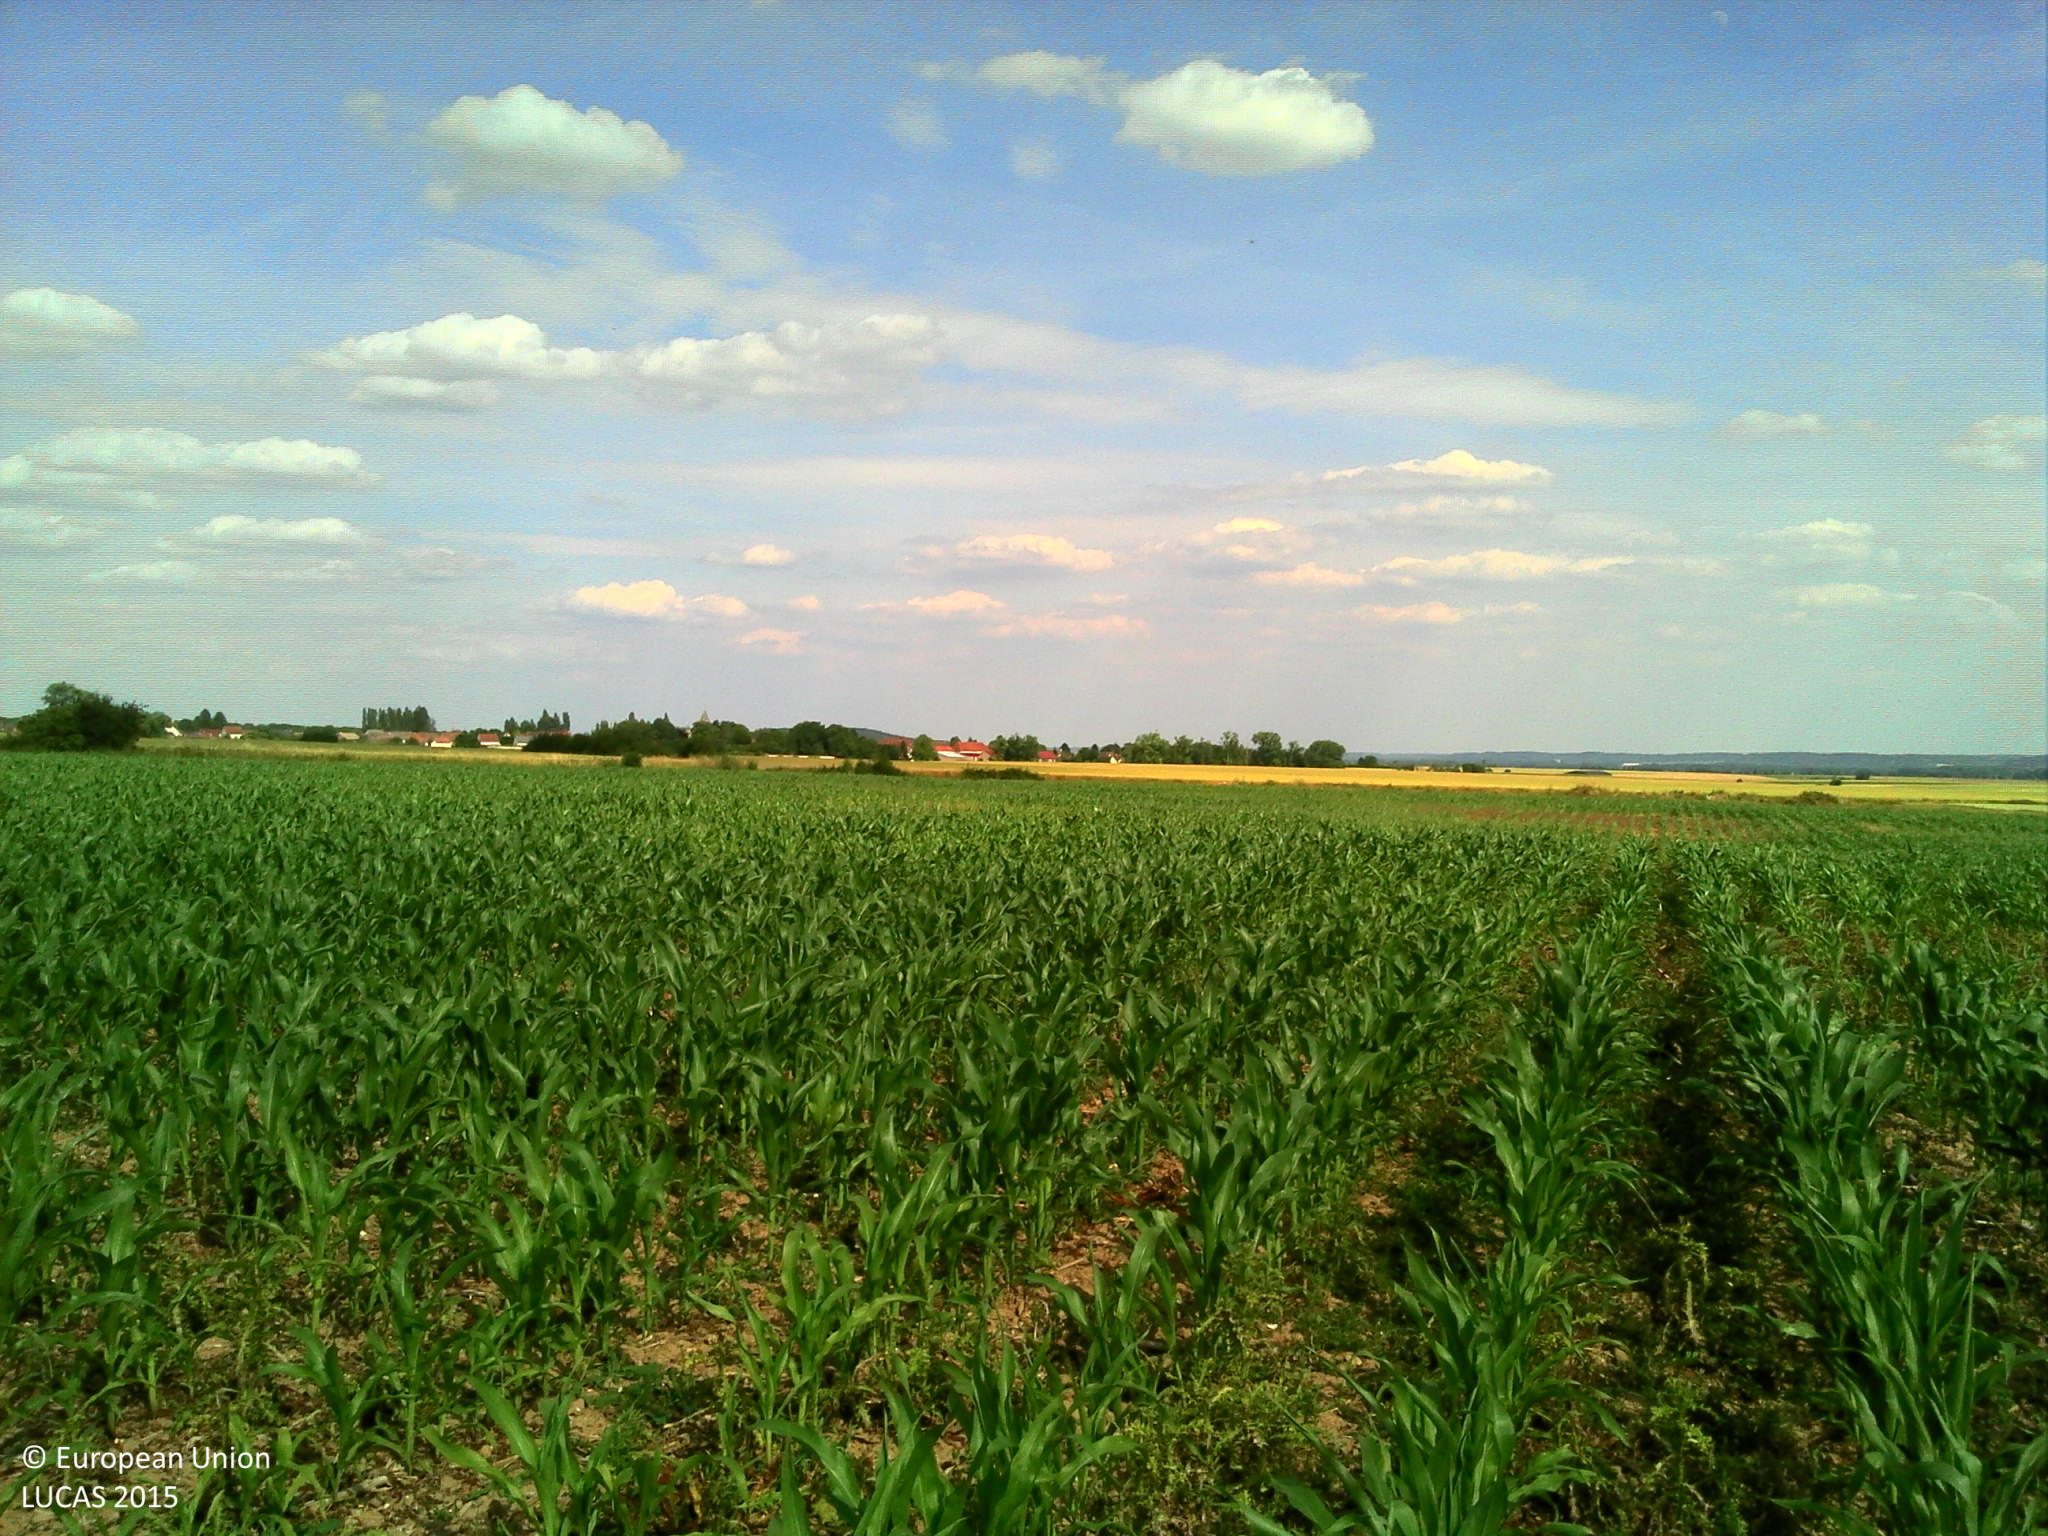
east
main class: Cropland
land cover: Maize
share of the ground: 50 - 75 %
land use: Agriculture (excluding fallow land and kitchen gardens)
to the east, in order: Maize; Grass margins; Tracks; Grass margins; Common wheat
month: June
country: FR
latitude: 49.3814
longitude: 2.5639
